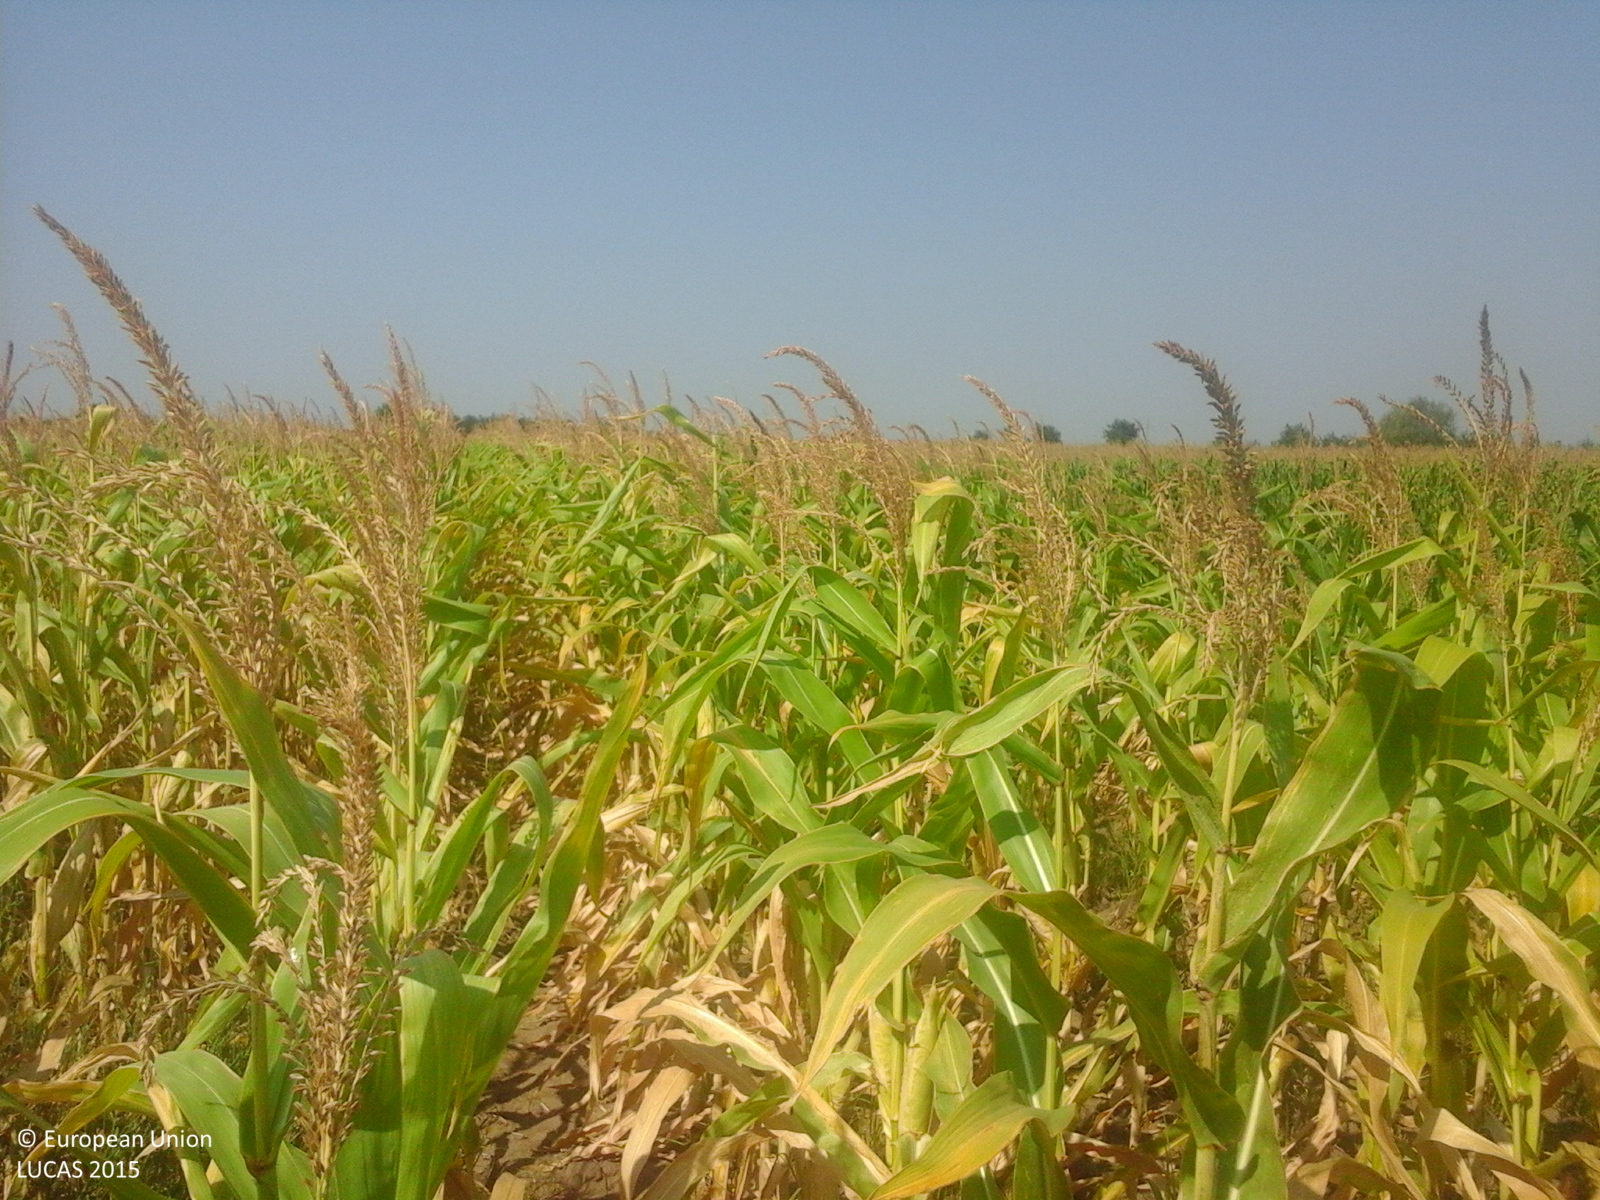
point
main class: Cropland
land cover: Maize
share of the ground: > 75 %
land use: Agriculture (excluding fallow land and kitchen gardens)
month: August
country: RO
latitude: 45.7420
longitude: 27.4942
